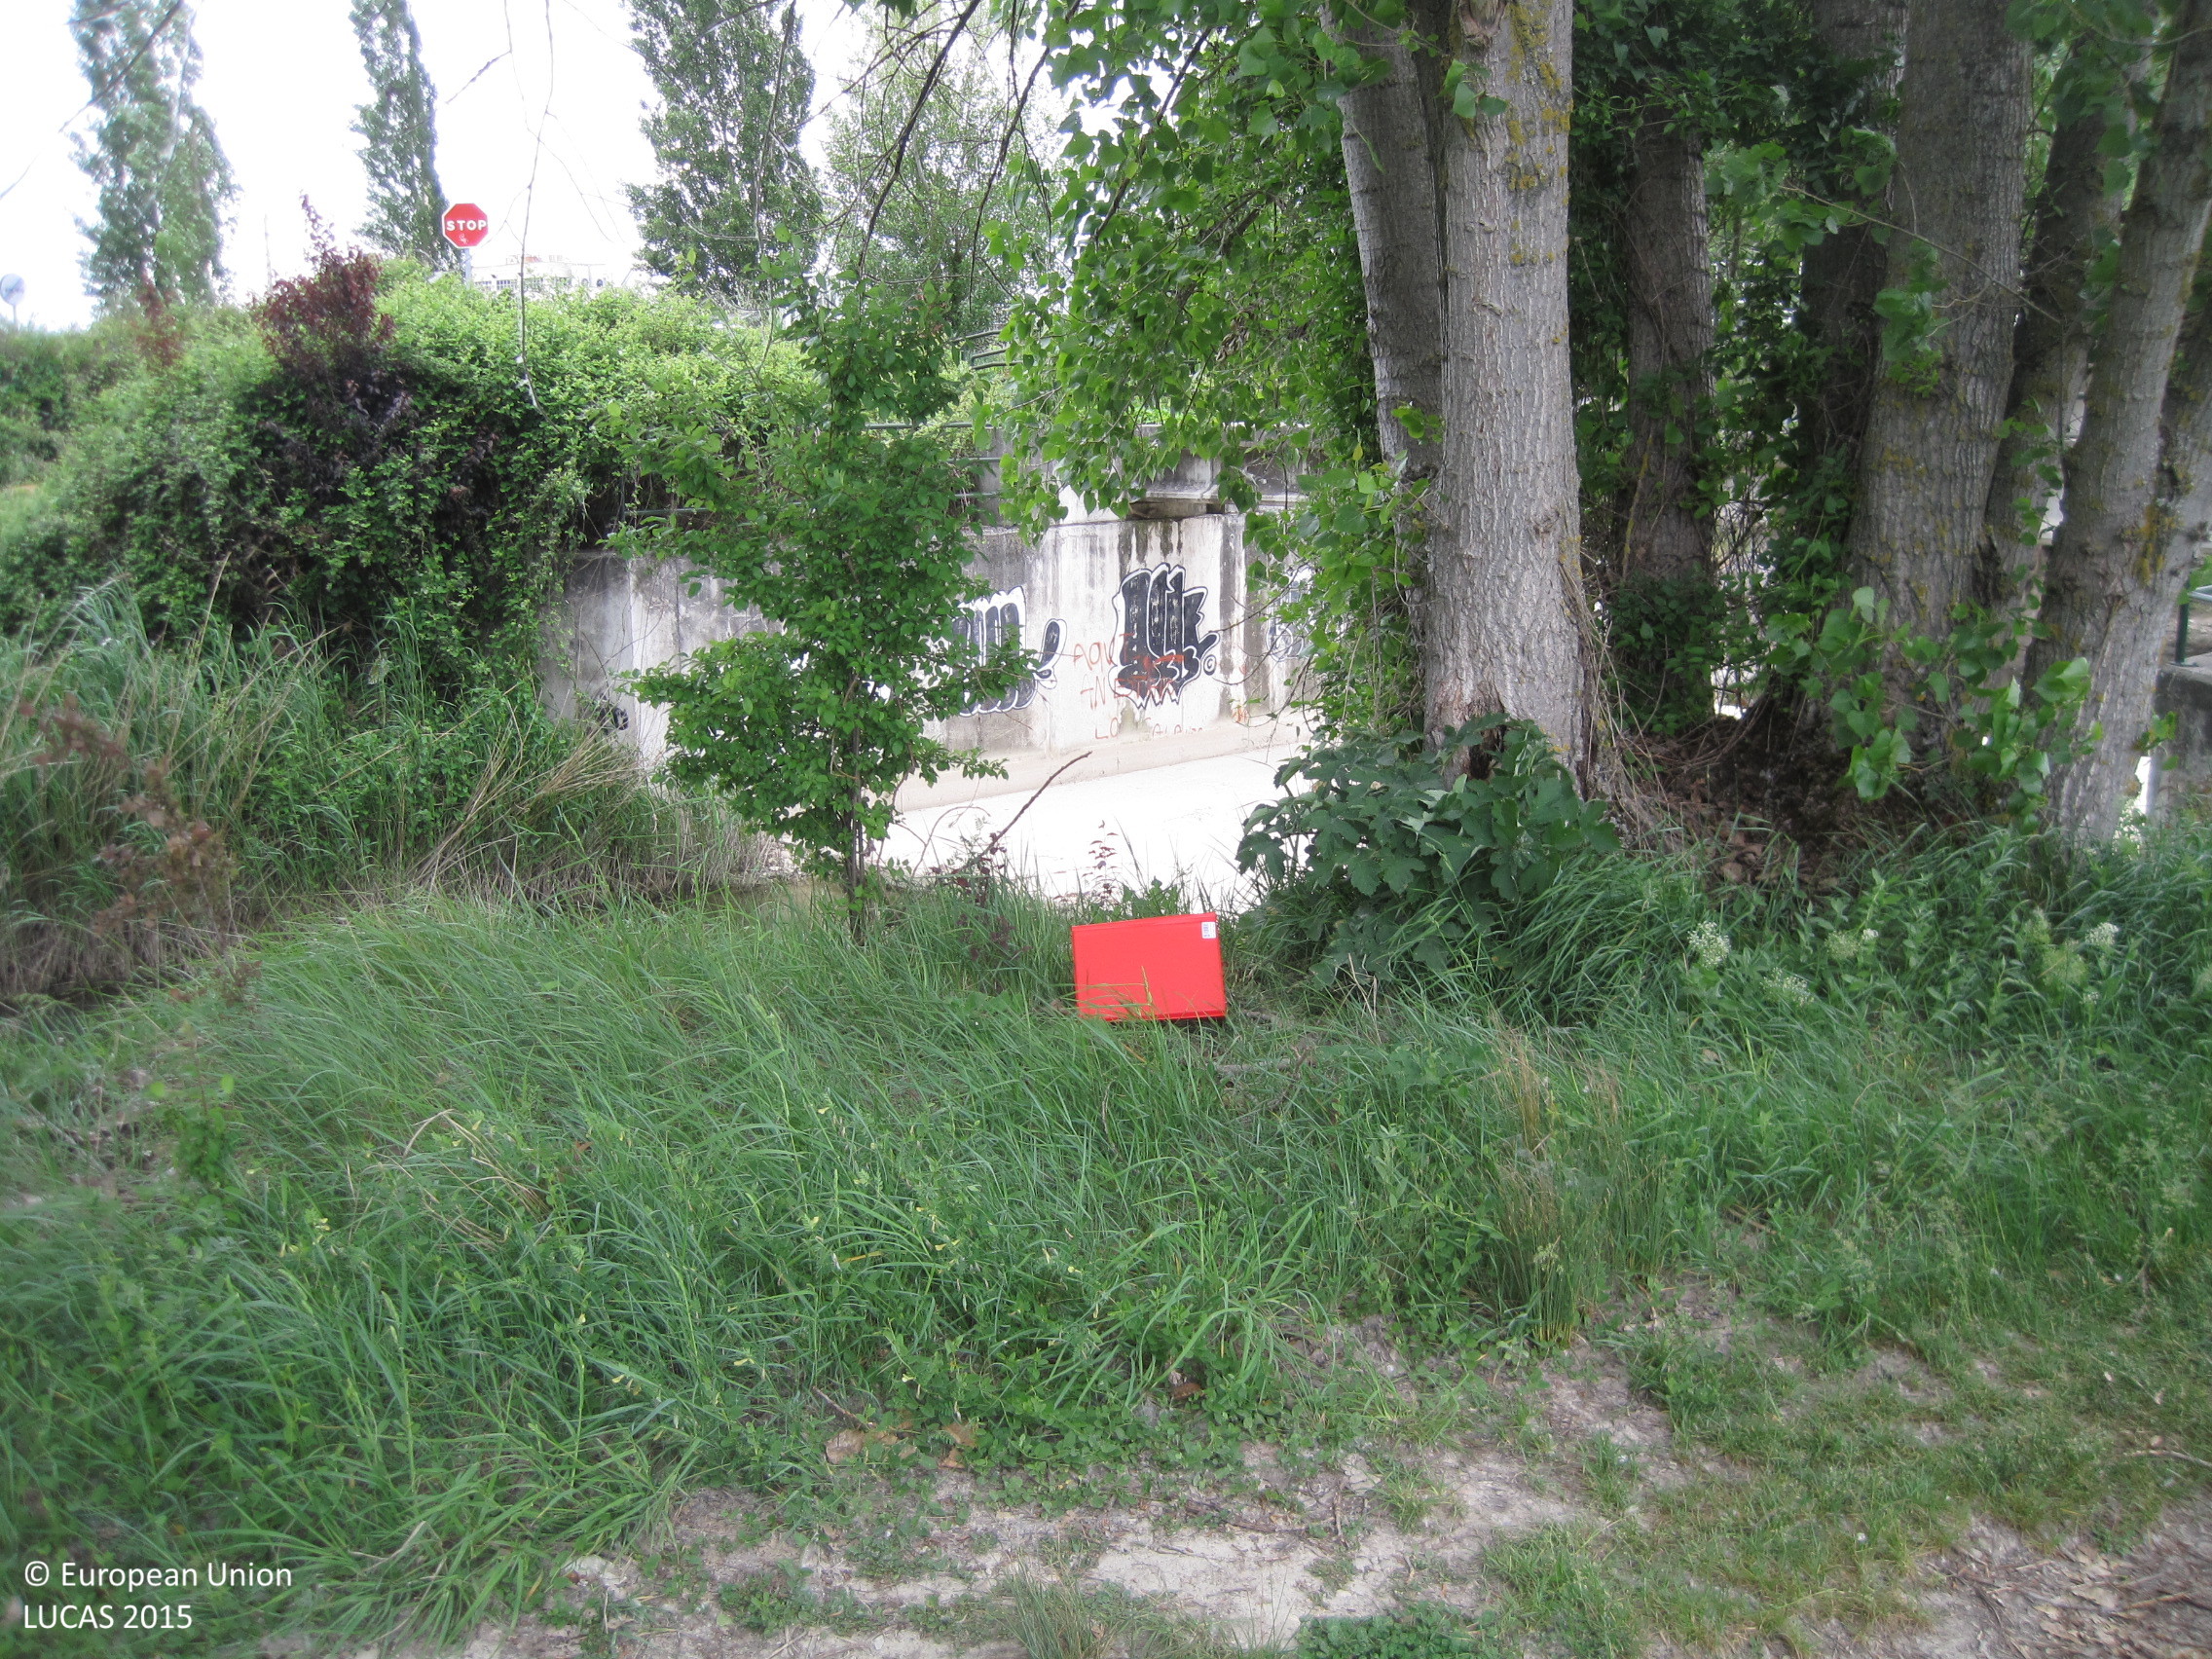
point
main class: Woodland
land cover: Broadleaved woodland
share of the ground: > 75 %
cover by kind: broadleaved forest trees 100 %
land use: Semi-natural and natural areas not in use
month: May
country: ES
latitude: 42.7975
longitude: -1.6667
